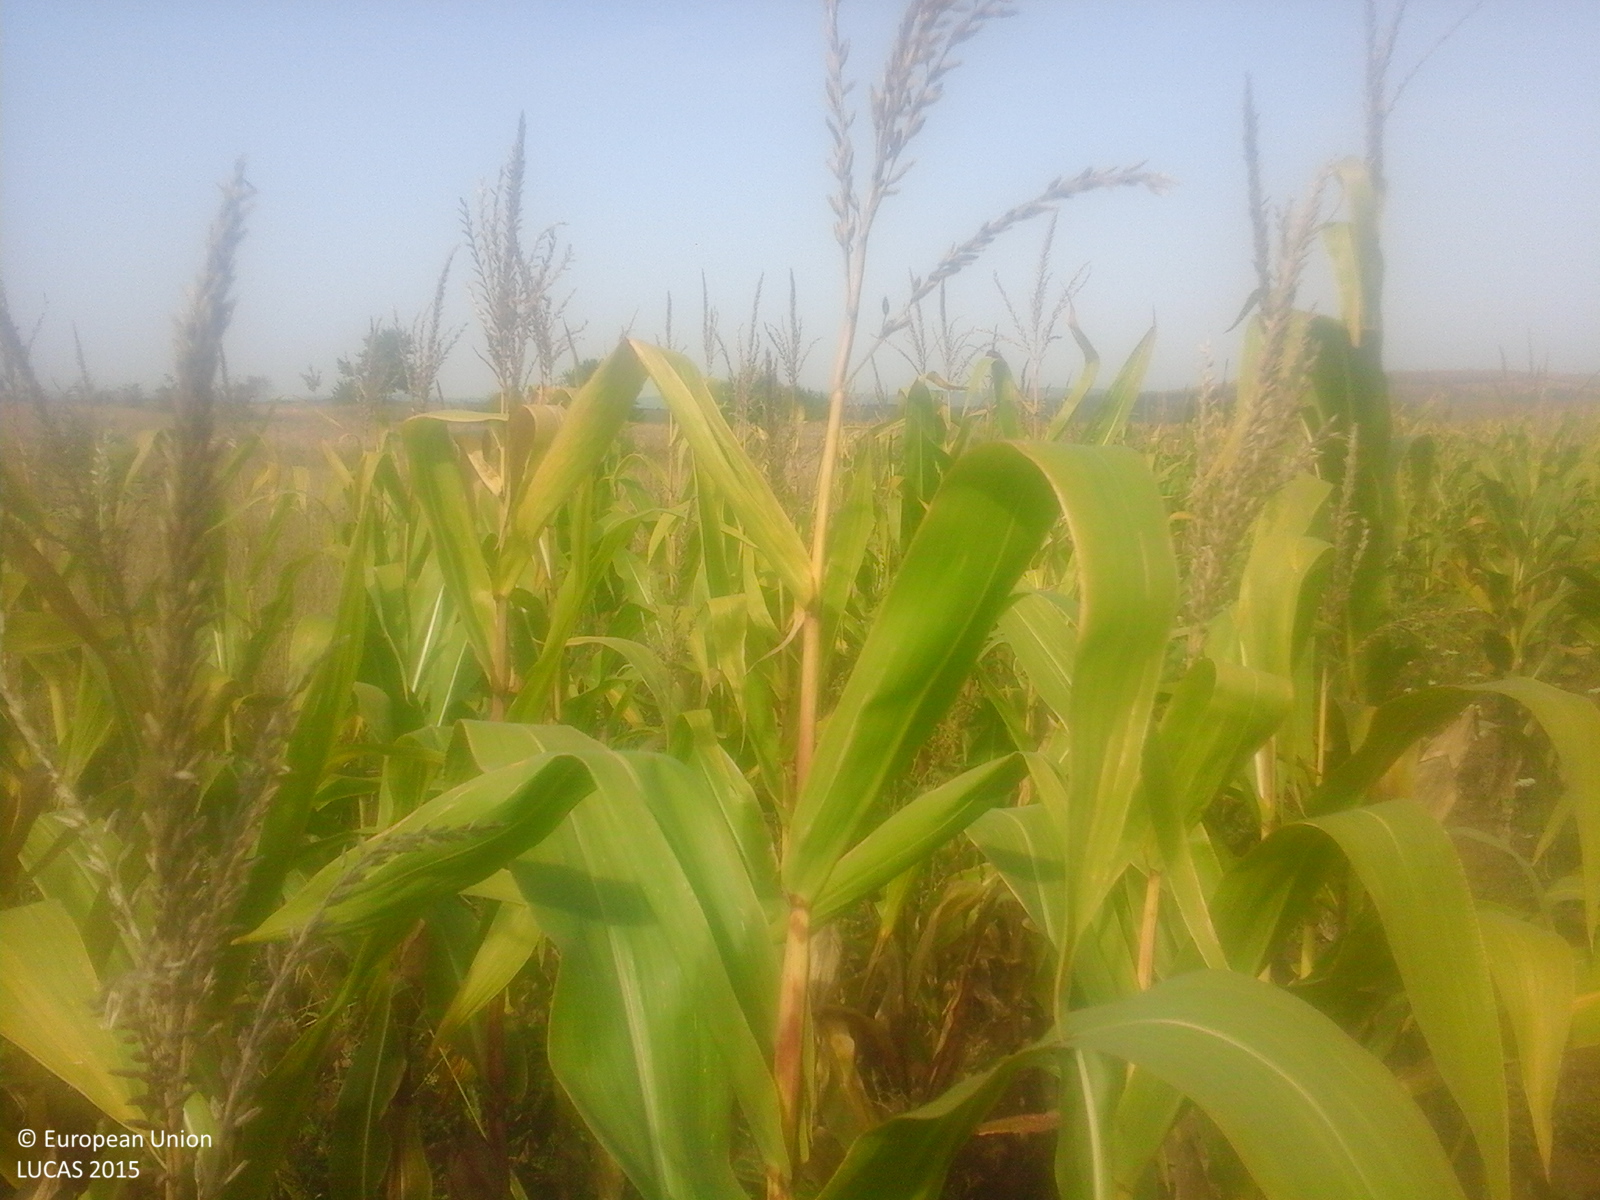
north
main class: Cropland
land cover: Maize
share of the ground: > 75 %
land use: Agriculture (excluding fallow land and kitchen gardens)
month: September
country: RO
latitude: 45.5242
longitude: 22.9449
